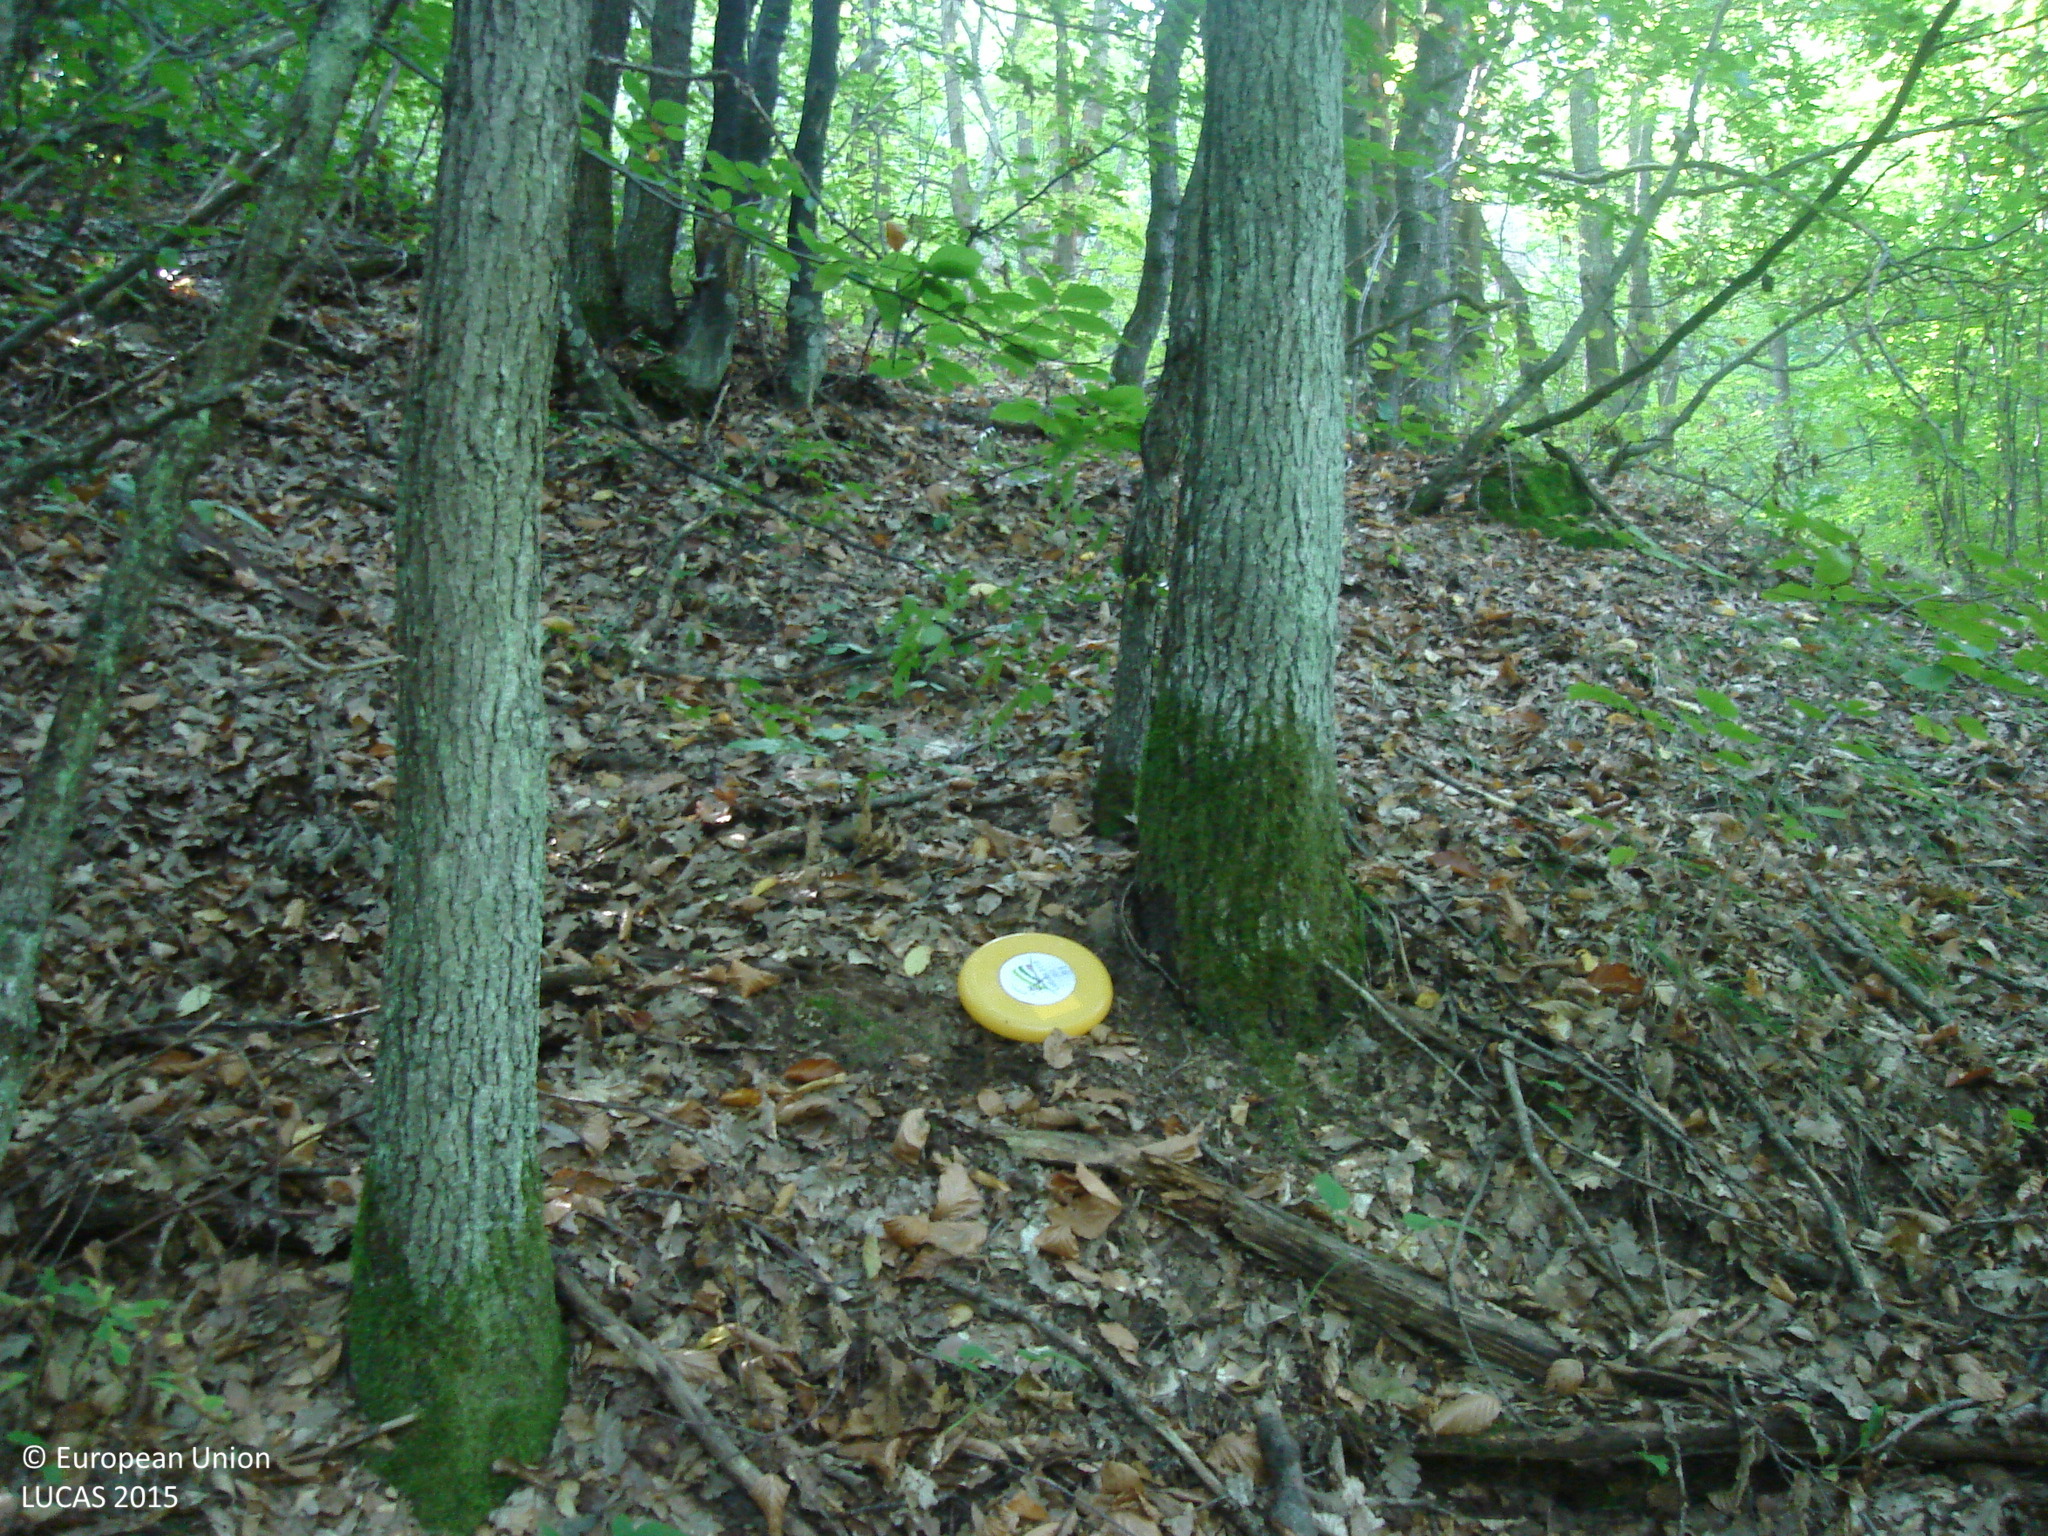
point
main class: Woodland
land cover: Broadleaved woodland
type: thermophilous deciduous forest
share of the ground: > 75 %
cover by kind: broadleaved forest trees 100 %
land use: Forestry
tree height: > 5 m
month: September
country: BG
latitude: 42.8973
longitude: 23.2241
